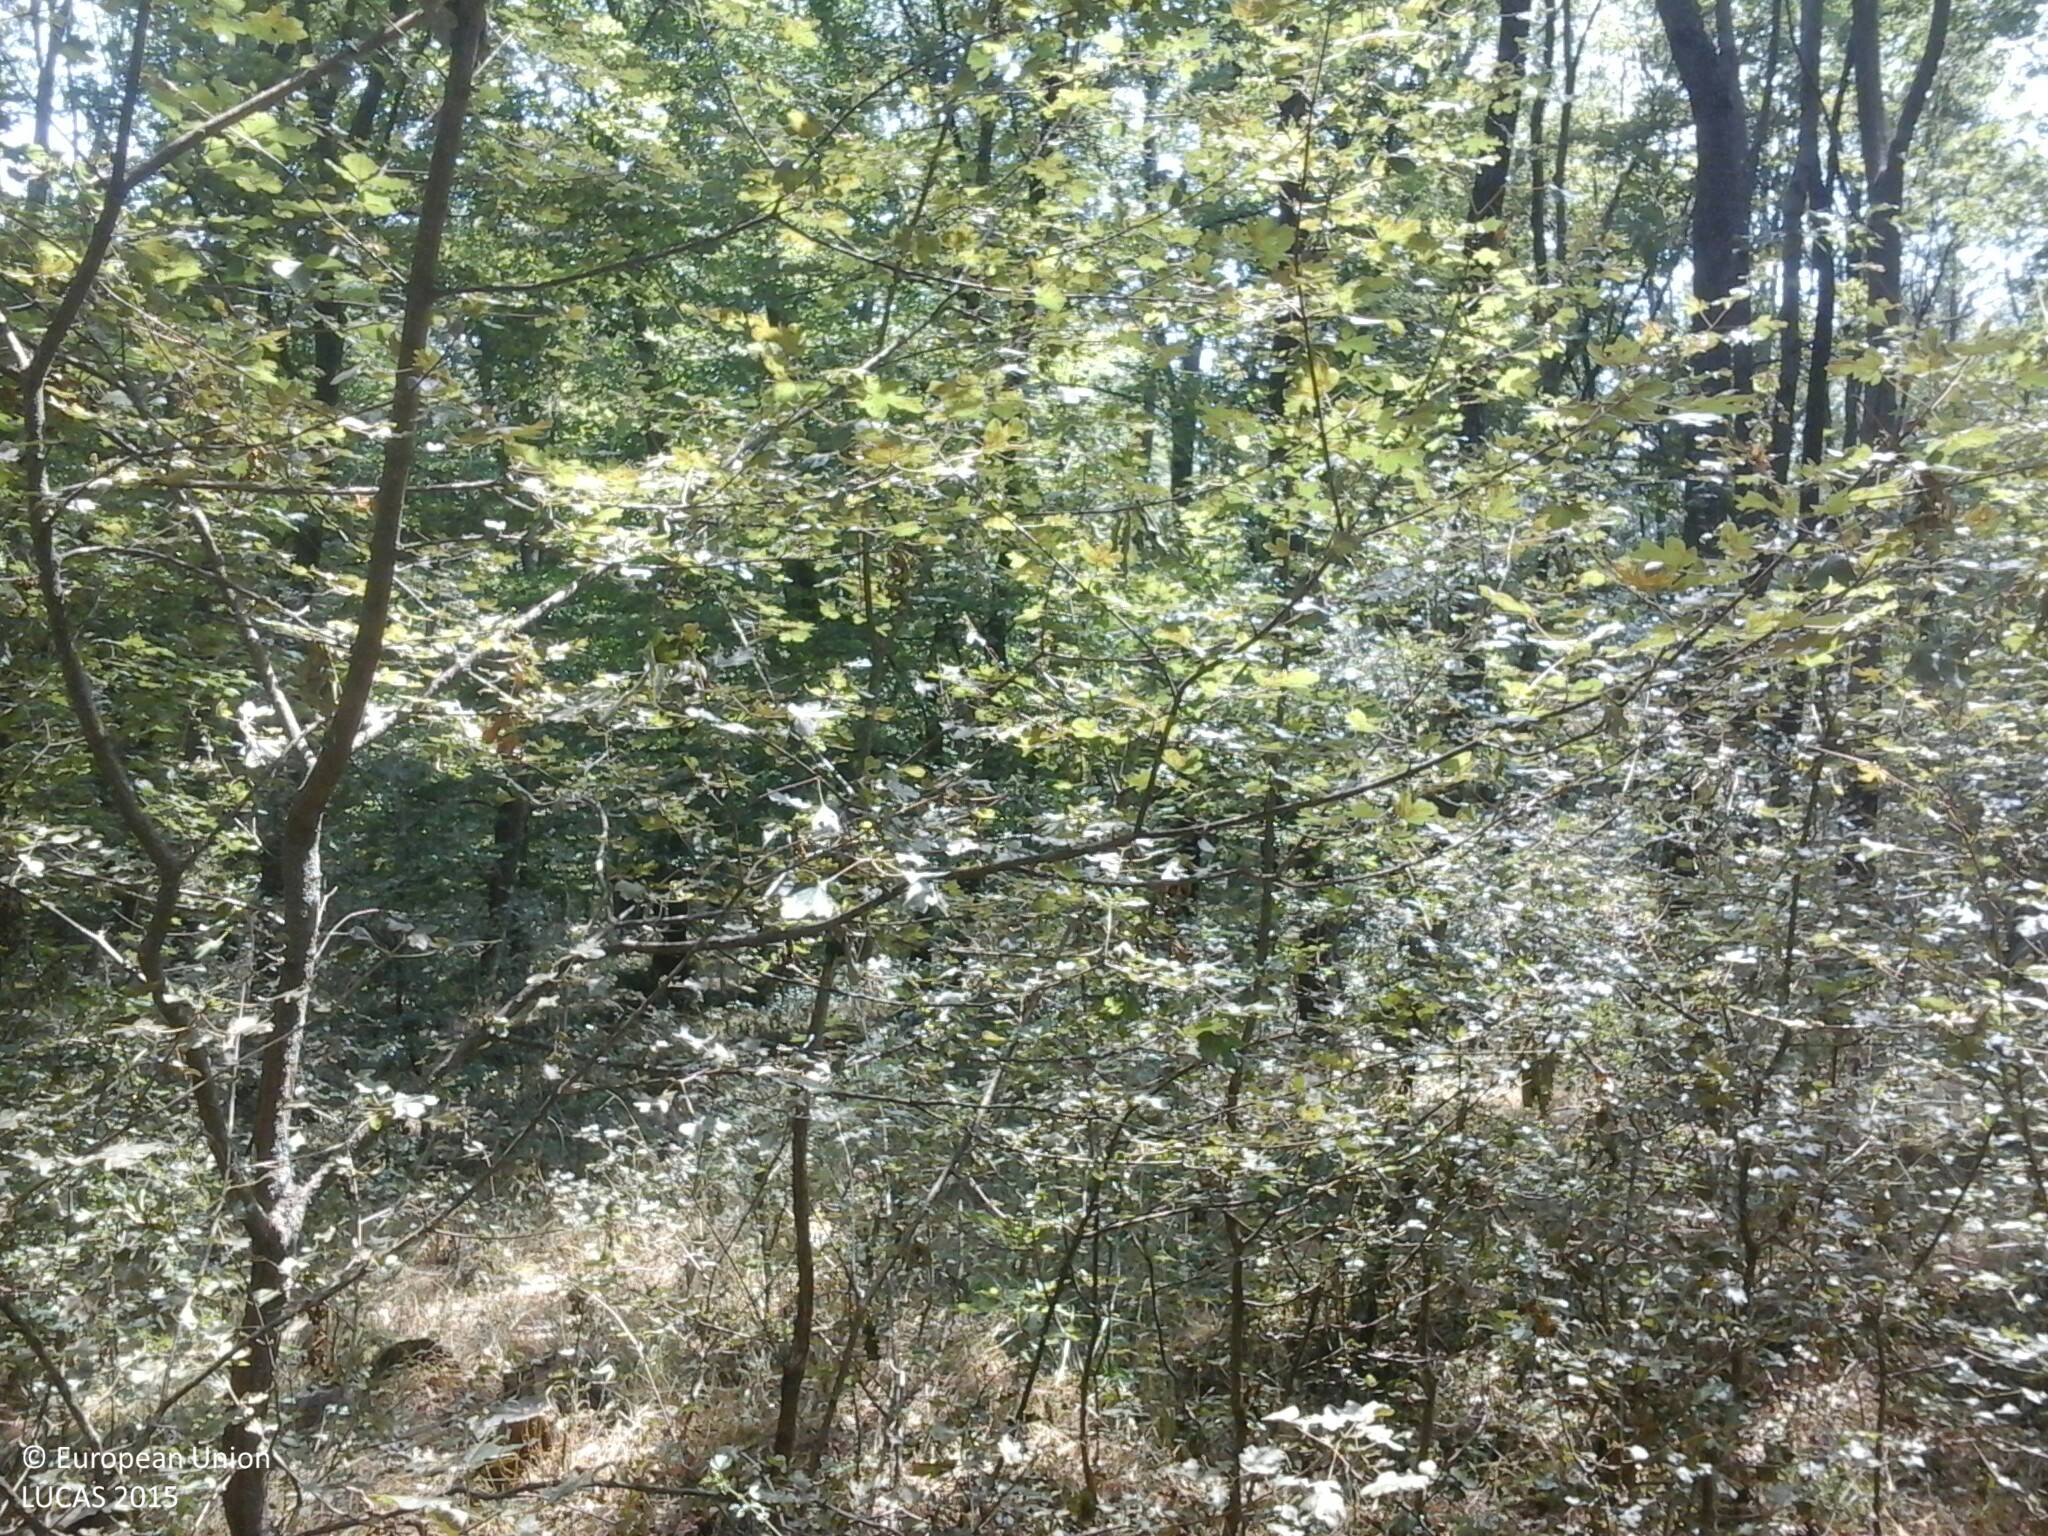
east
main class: Woodland
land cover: Broadleaved woodland
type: acidophilous oak and oak-birch forest
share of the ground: > 75 %
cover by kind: broadleaved forest trees 75 %, shrubs 15 %, herbaceous plants 10 %
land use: Forestry
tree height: < 5 m
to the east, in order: Broadleaved woodland; Tracks; Broadleaved woodland; Tracks; Broadleaved woodland; Tracks; Other coniferous woodland; Rock outcrops; Other coniferous woodland
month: July
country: HU
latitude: 47.1972
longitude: 17.9159
